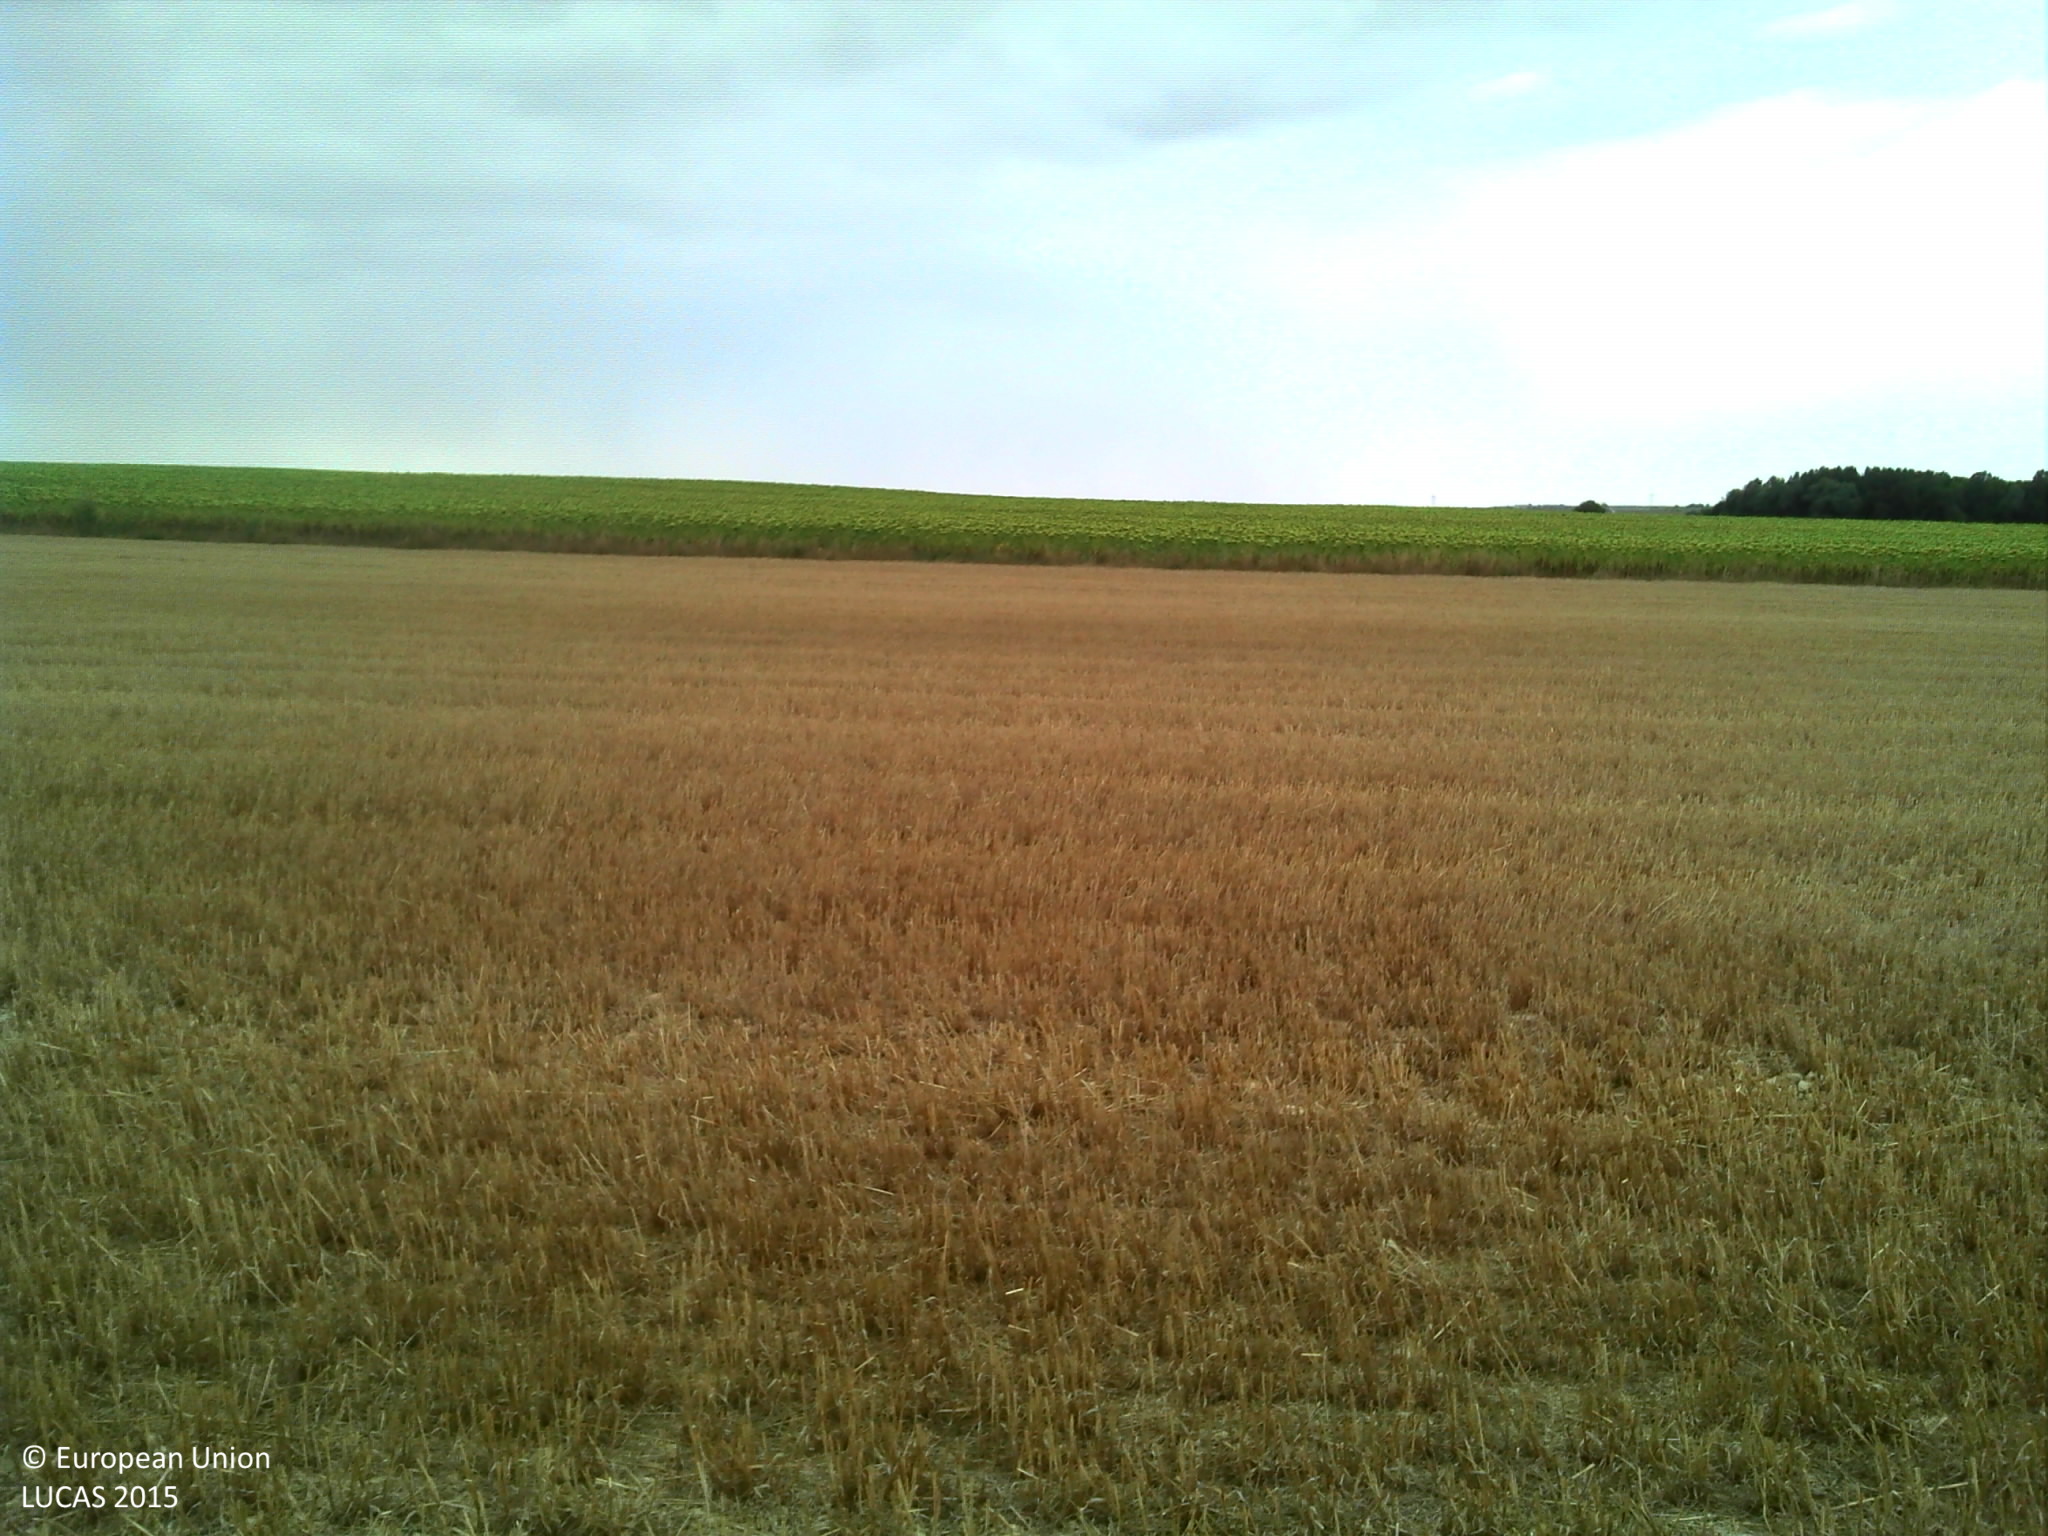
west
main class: Cropland
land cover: Common wheat
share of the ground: > 75 %
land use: Agriculture (excluding fallow land and kitchen gardens)
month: July
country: FR
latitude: 46.8310
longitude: 2.2711
